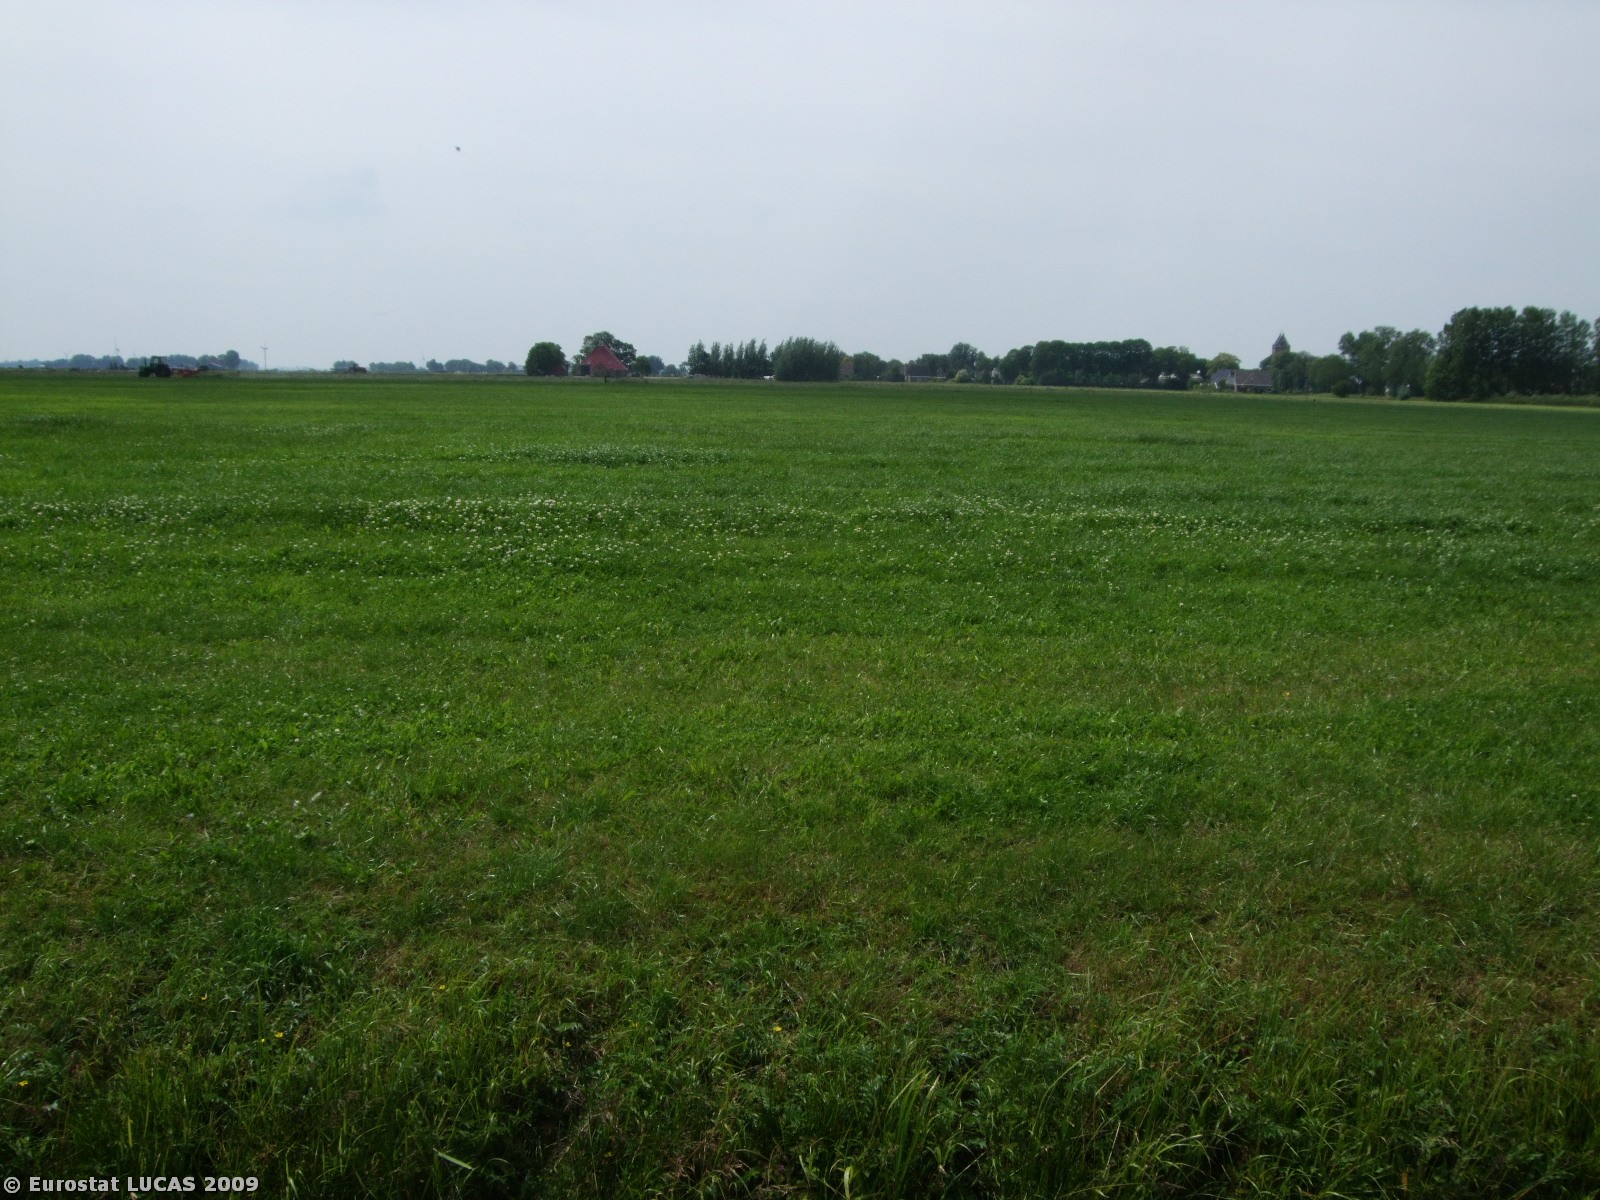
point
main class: Grassland
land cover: Grassland without tree/shrub cover
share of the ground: > 75 %
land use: Agriculture (excluding fallow land and kitchen gardens)
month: June
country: NL
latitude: 53.1427
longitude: 5.6186
